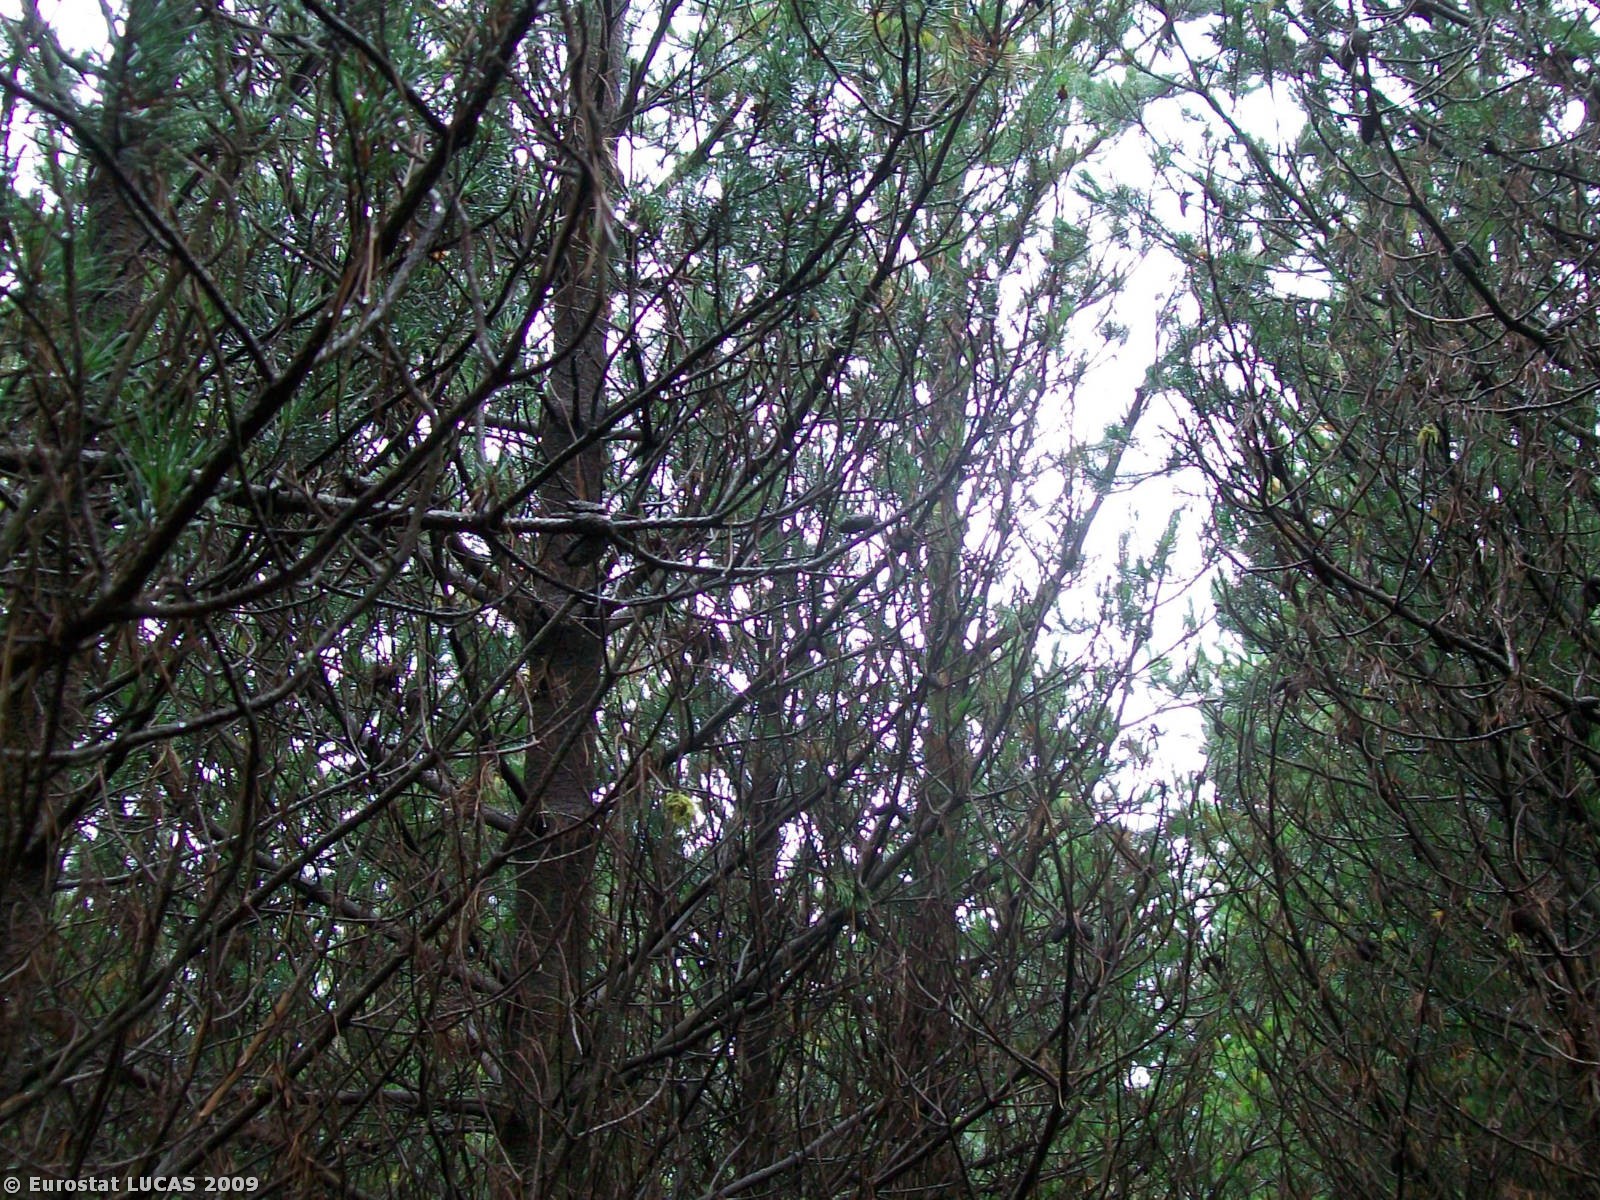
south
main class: Woodland
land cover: Coniferous woodland
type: plantations and self-sown exotic forest
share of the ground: > 75 %
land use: Forestry
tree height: > 5 m
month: August
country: GB
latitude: 58.6245
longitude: -3.1973
